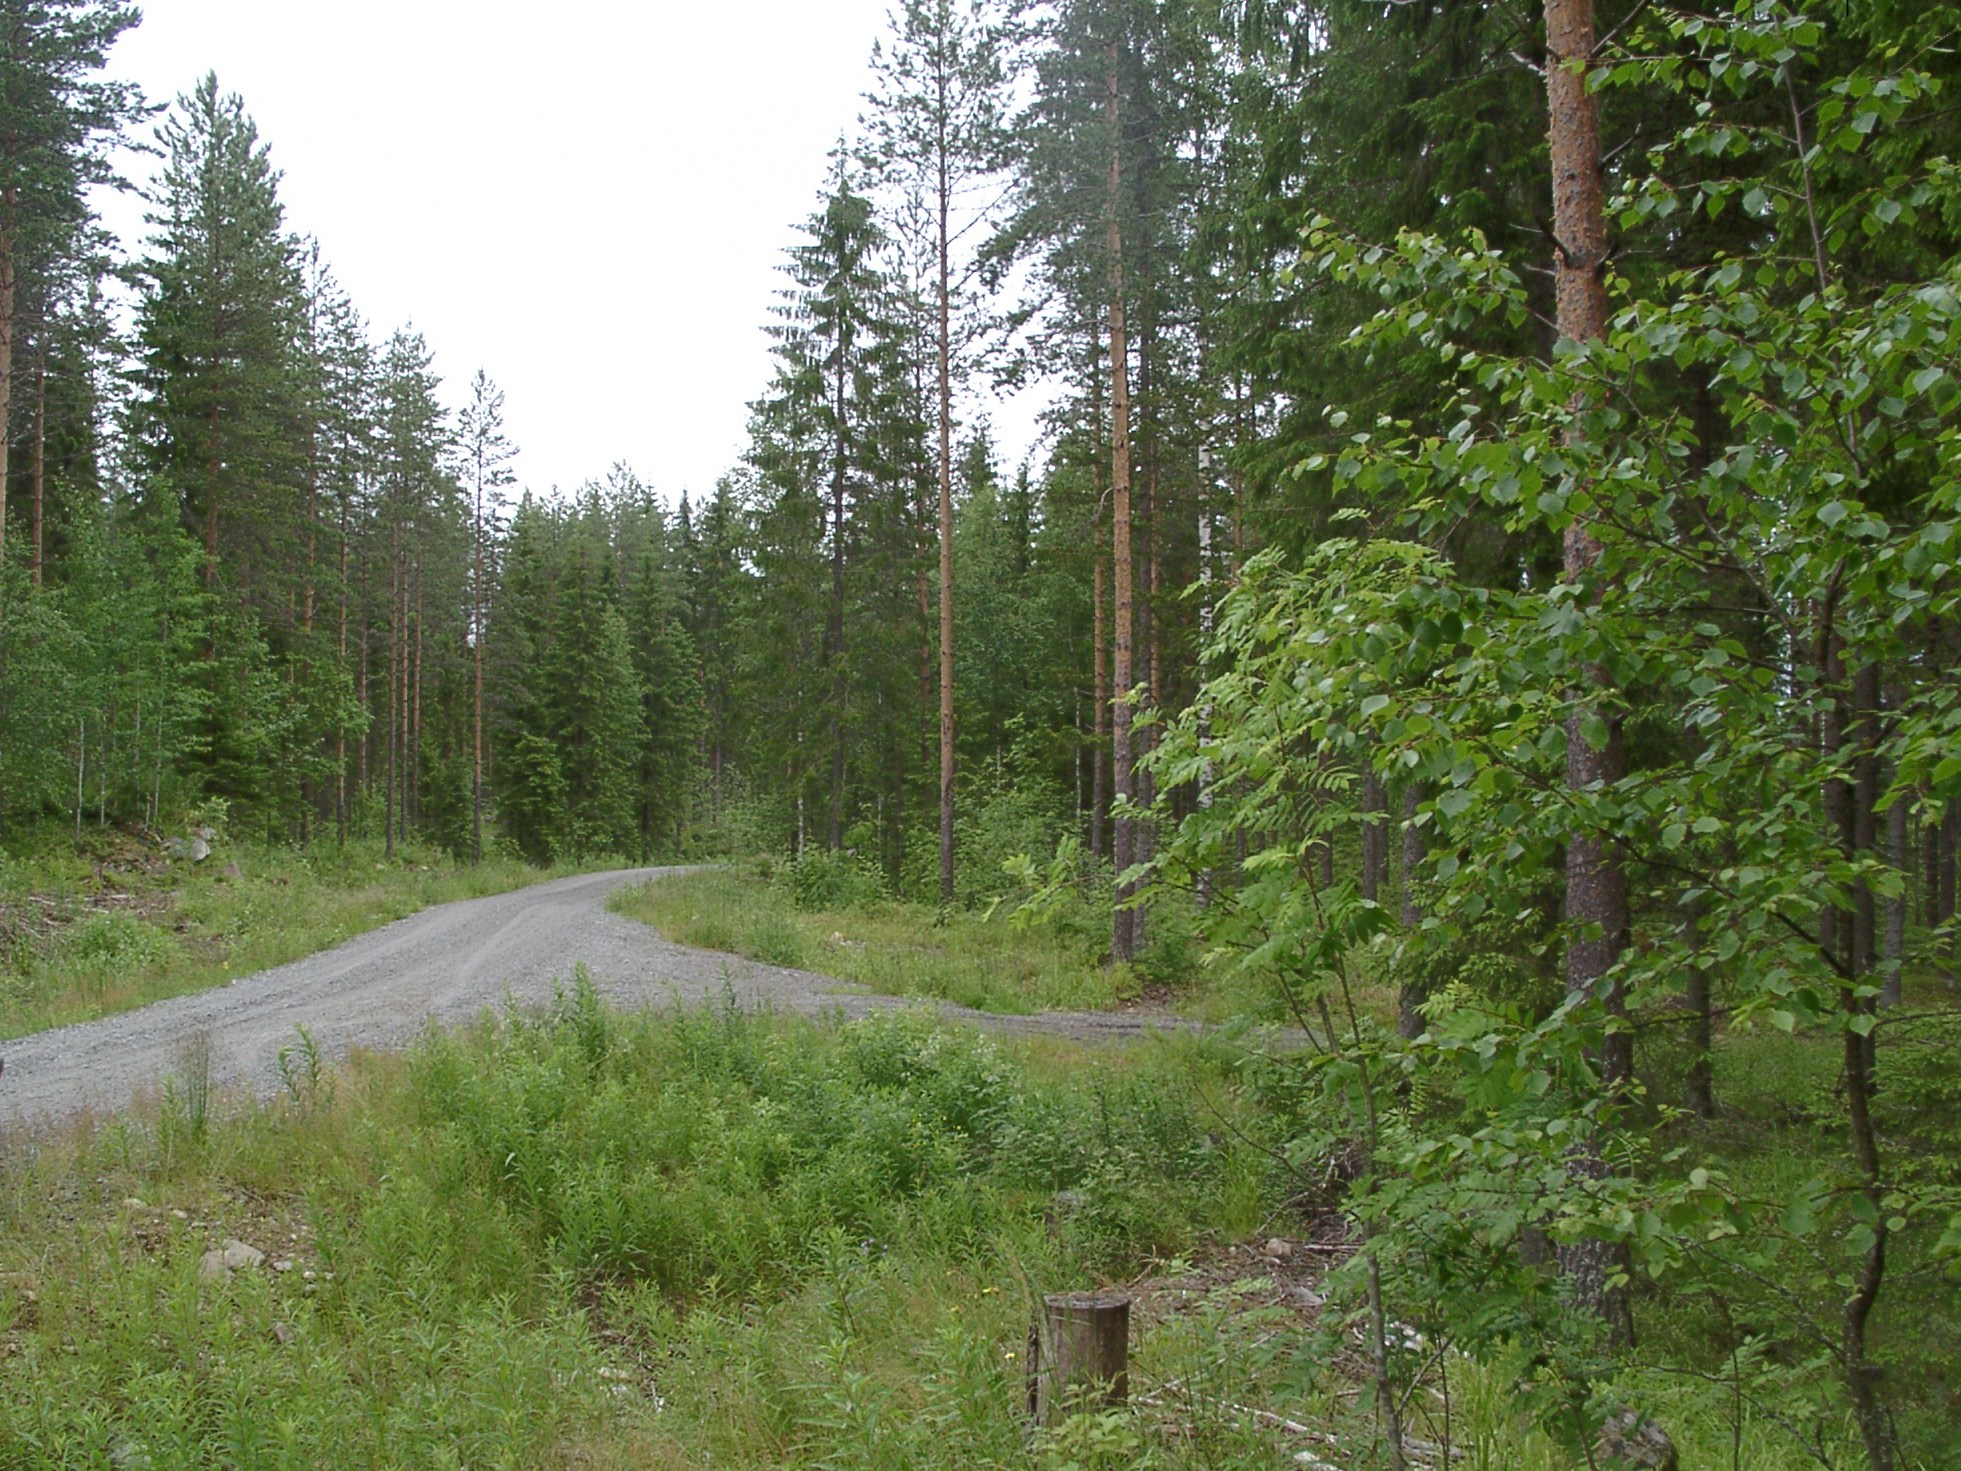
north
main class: Woodland
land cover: Other coniferous woodland
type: boreal forest
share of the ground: 50 - 75 %
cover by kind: coniferous forest trees 65 %, shrubs 10 %, herbaceous plants 10 %, broadleaved forest trees 5 %, lichens and mosses 5 %
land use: Forestry
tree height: > 5 m
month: July
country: FI
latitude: 62.0587
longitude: 25.5166
